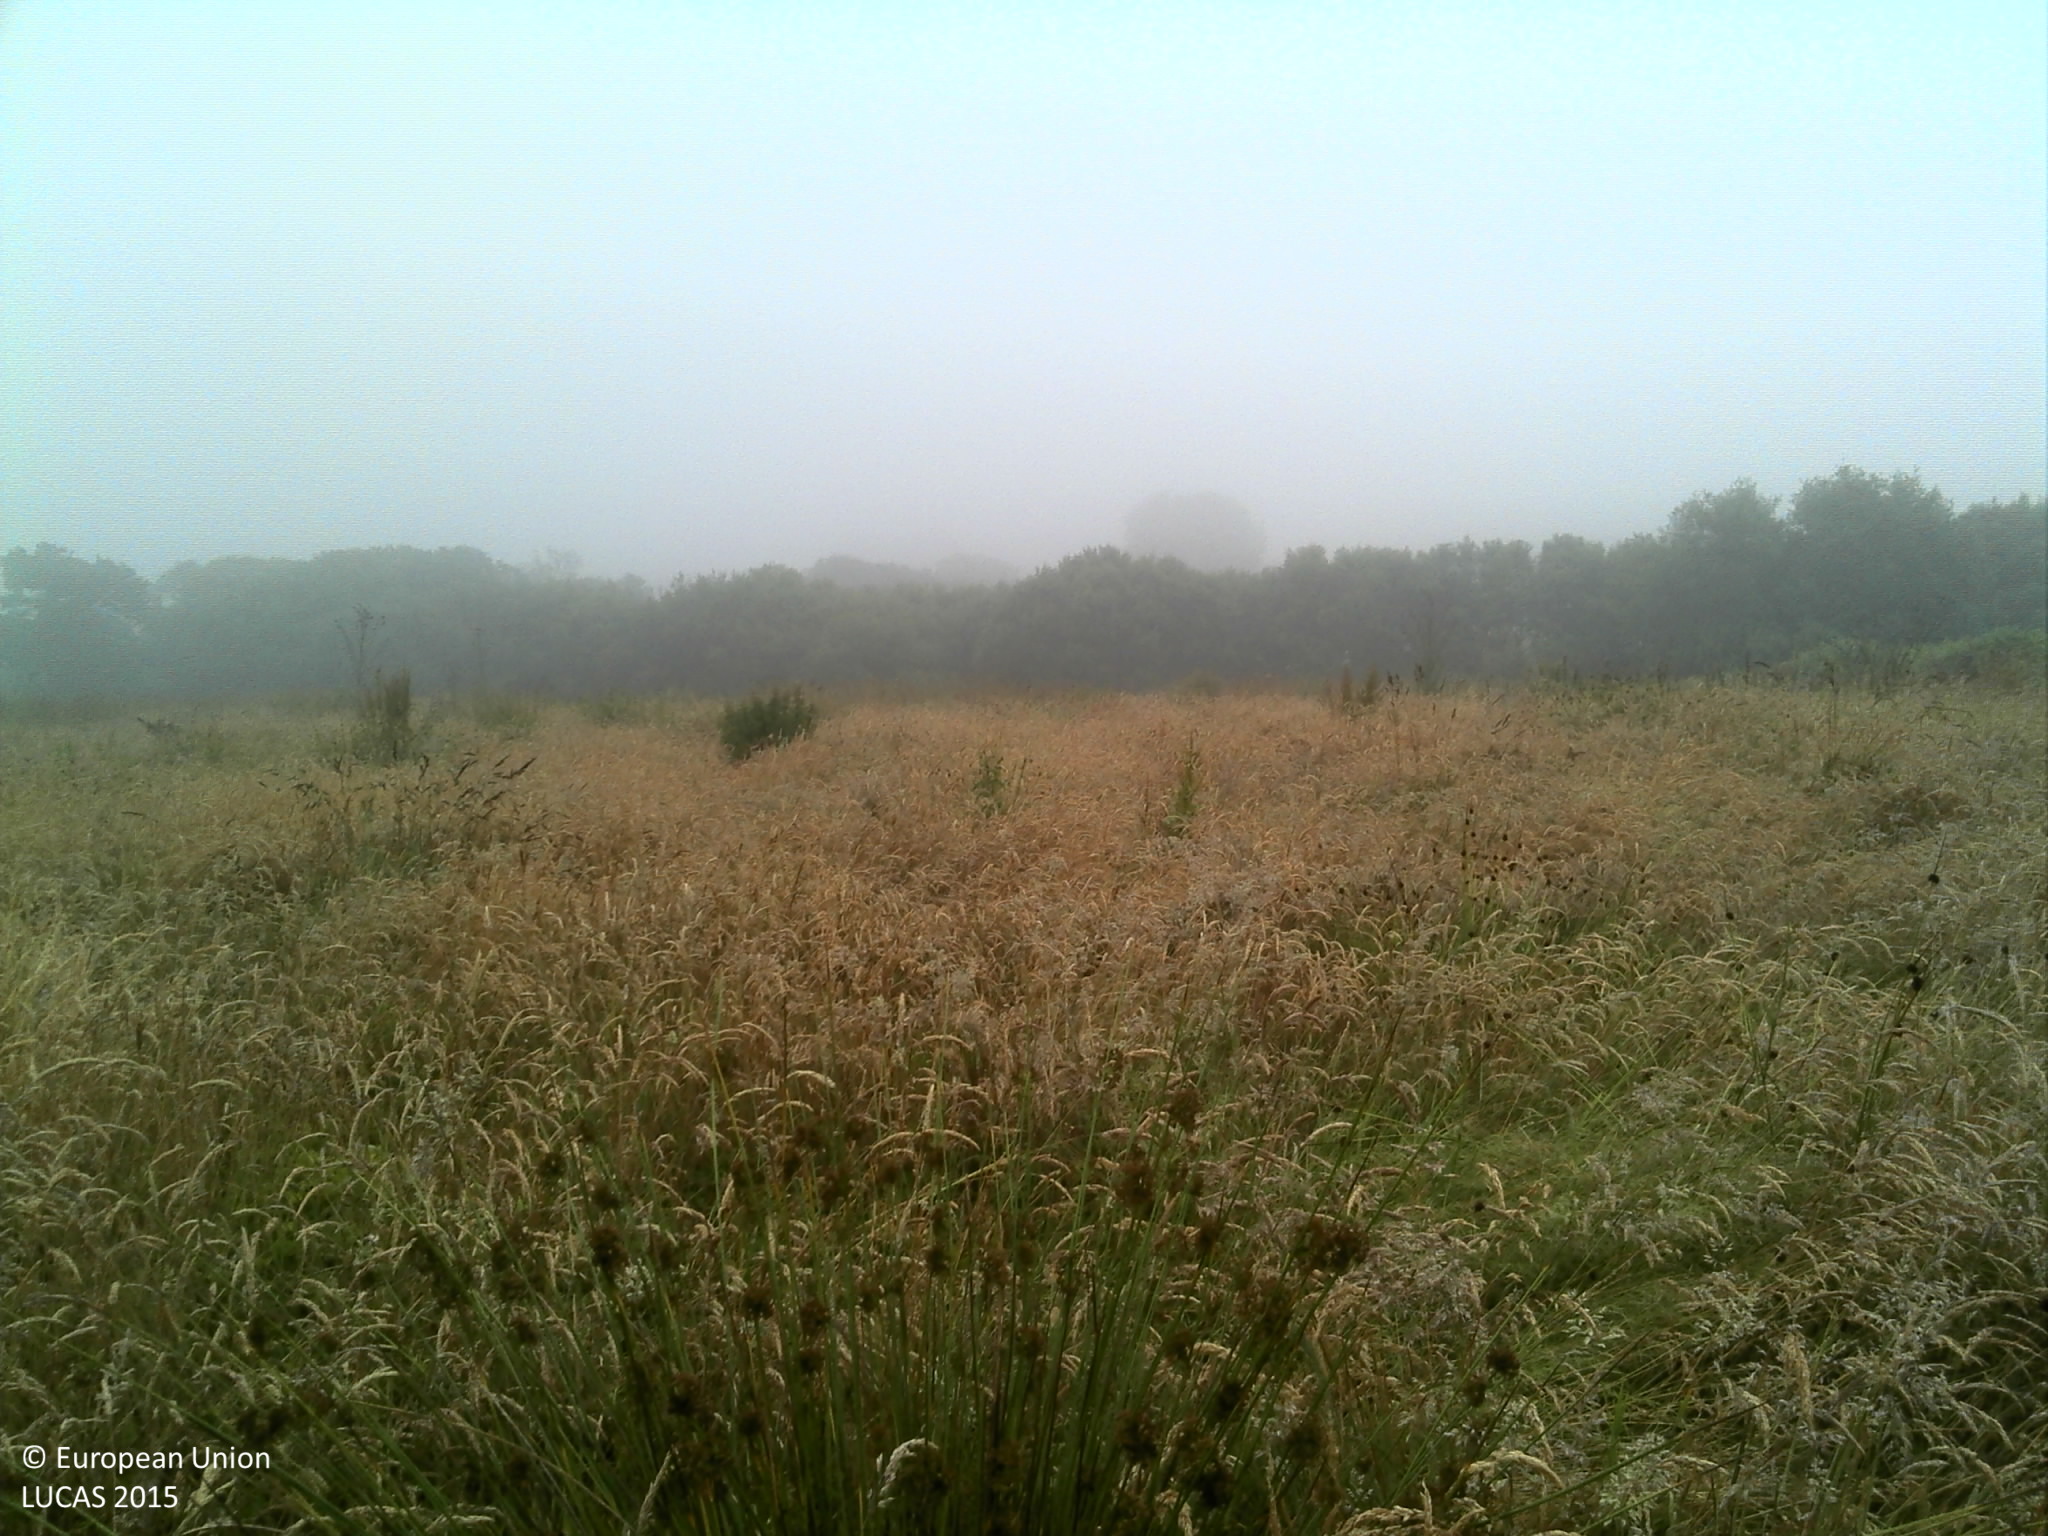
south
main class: Grassland
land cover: Grassland without tree/shrub cover
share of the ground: > 75 %
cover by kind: herbaceous plants 100 %
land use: Agriculture (excluding fallow land and kitchen gardens)
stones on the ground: < 10 %
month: July
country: FR
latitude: 48.2073
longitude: -4.2348
